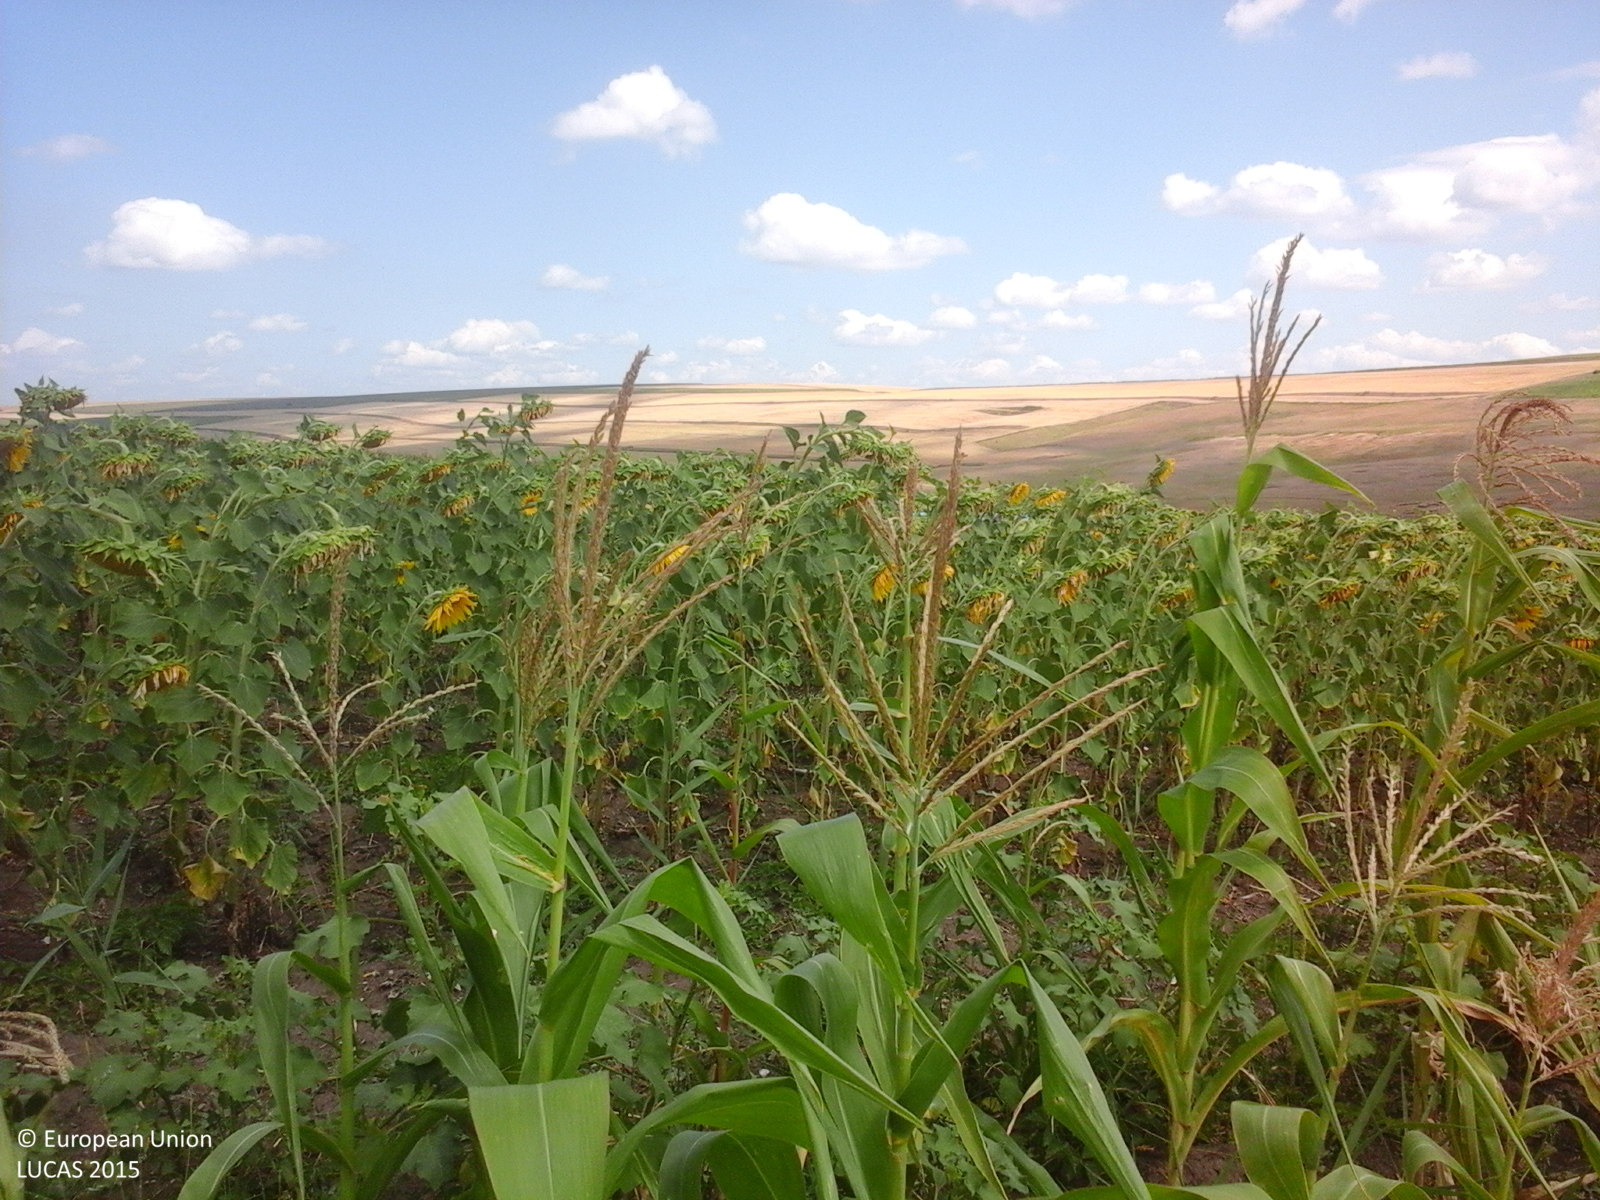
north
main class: Cropland
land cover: Maize
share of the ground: > 75 %
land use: Agriculture (excluding fallow land and kitchen gardens)
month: July
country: RO
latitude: 46.3660
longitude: 27.9443
